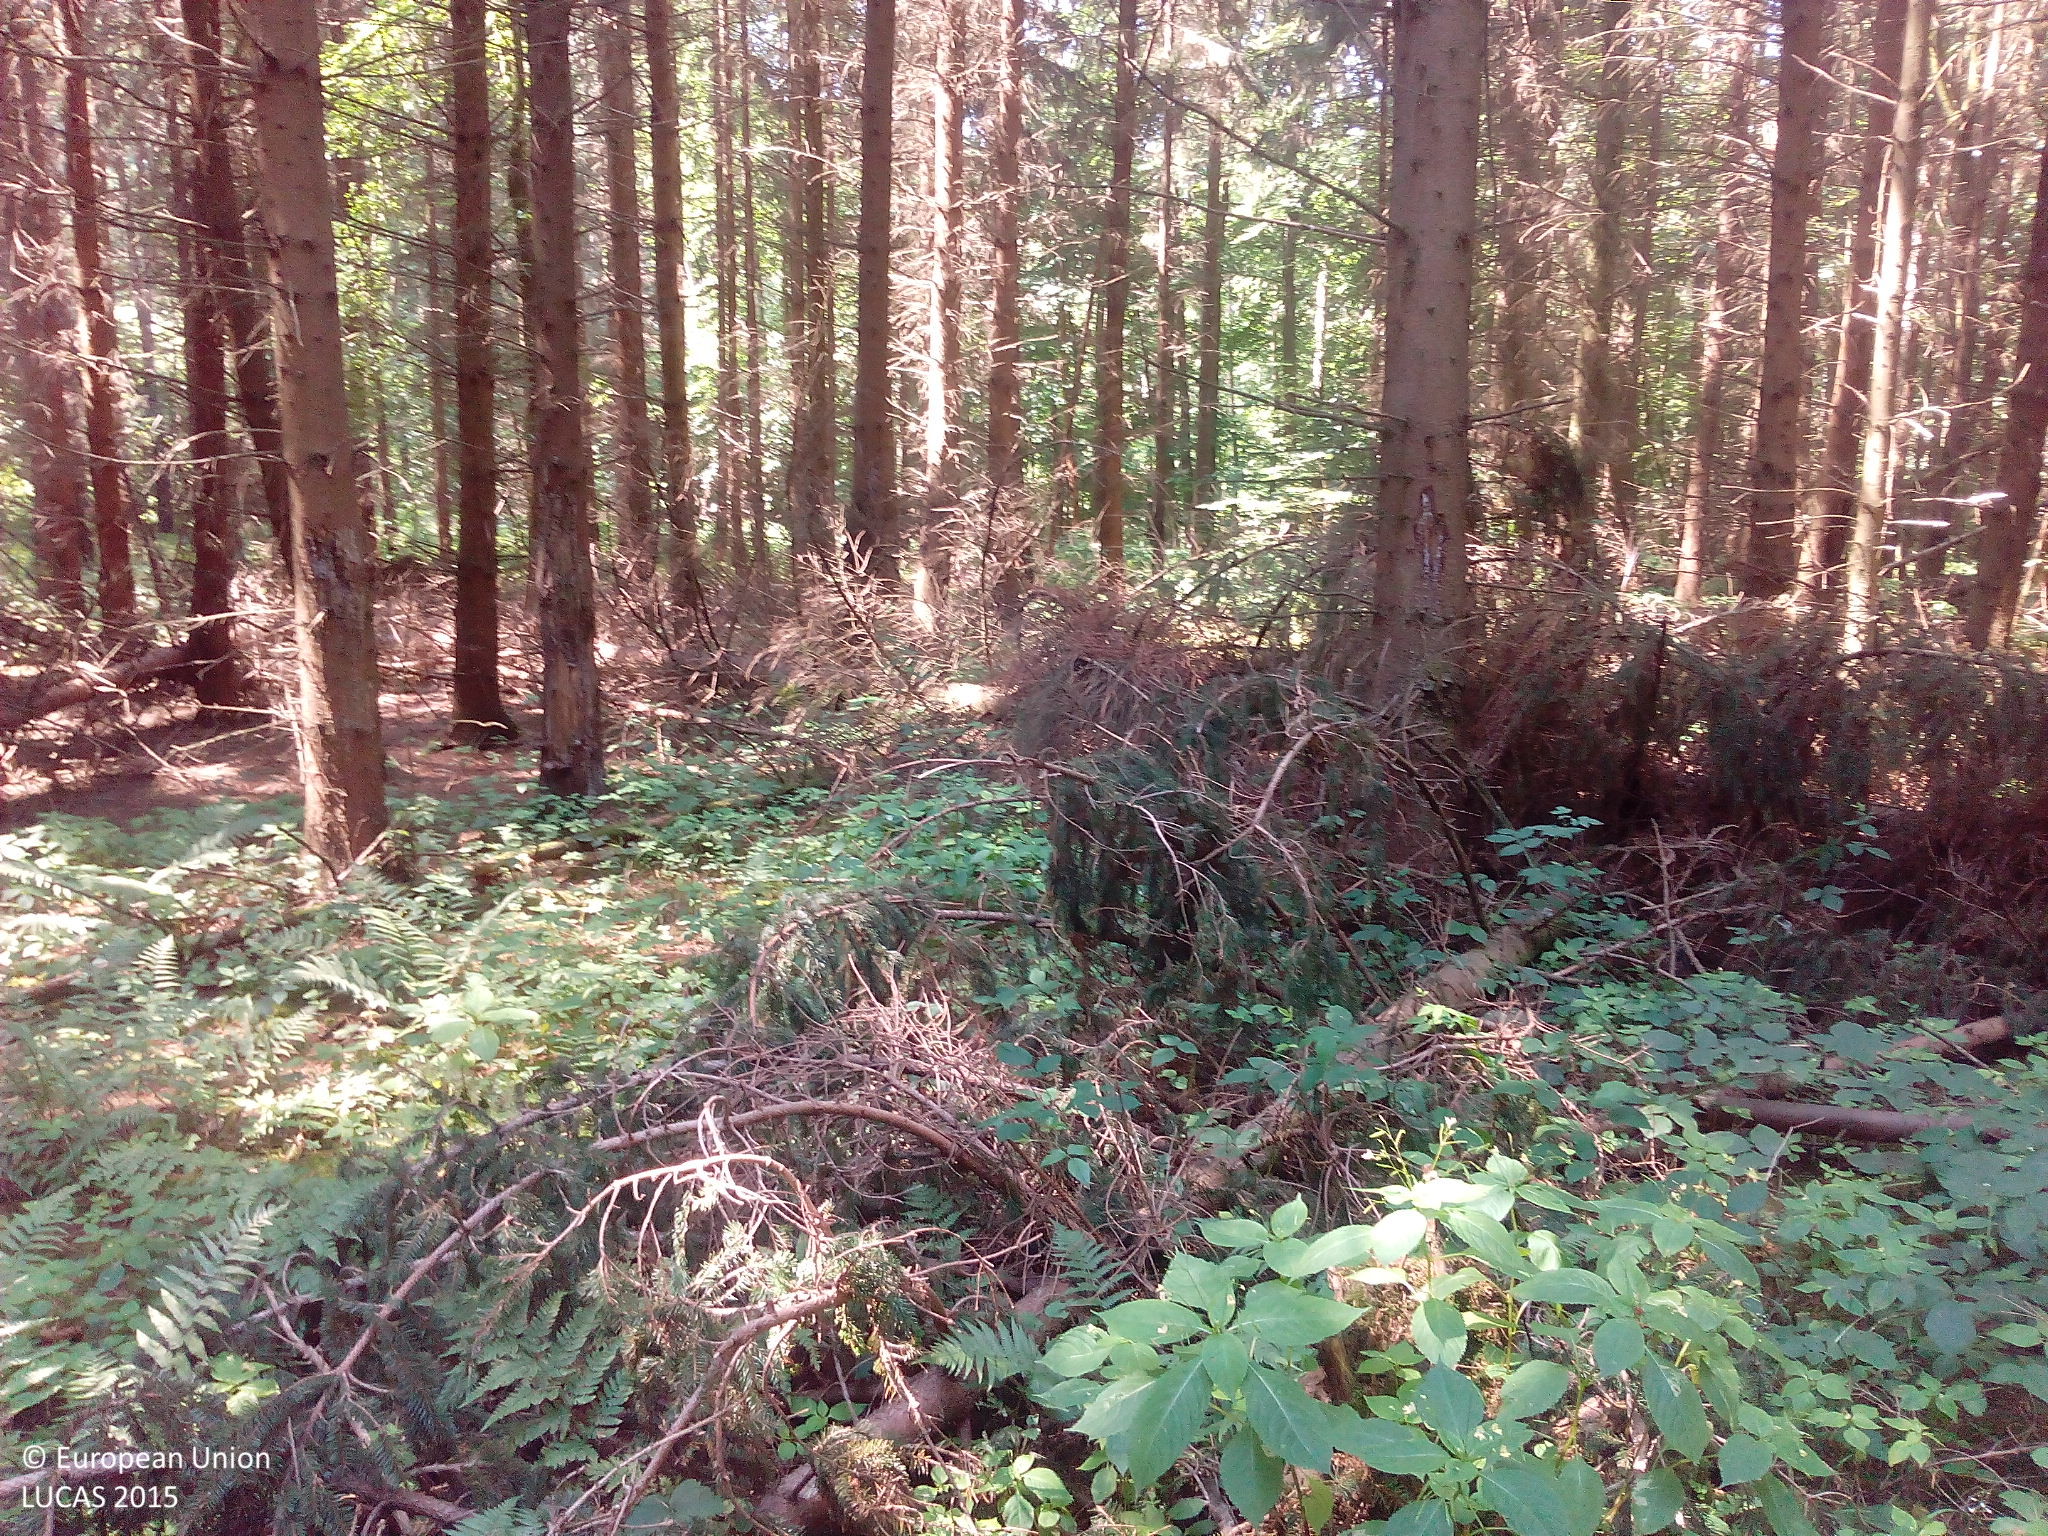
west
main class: Woodland
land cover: Spruce dominated coniferous woodland
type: hemiboreal forest and nemoral coniferous forest and mixed broadleaved-coniferous forest
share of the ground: > 75 %
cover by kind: coniferous forest trees 95 %, herbaceous plants 5 %
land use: Forestry
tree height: > 5 m
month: August
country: DE
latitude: 53.6466
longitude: 12.4651
